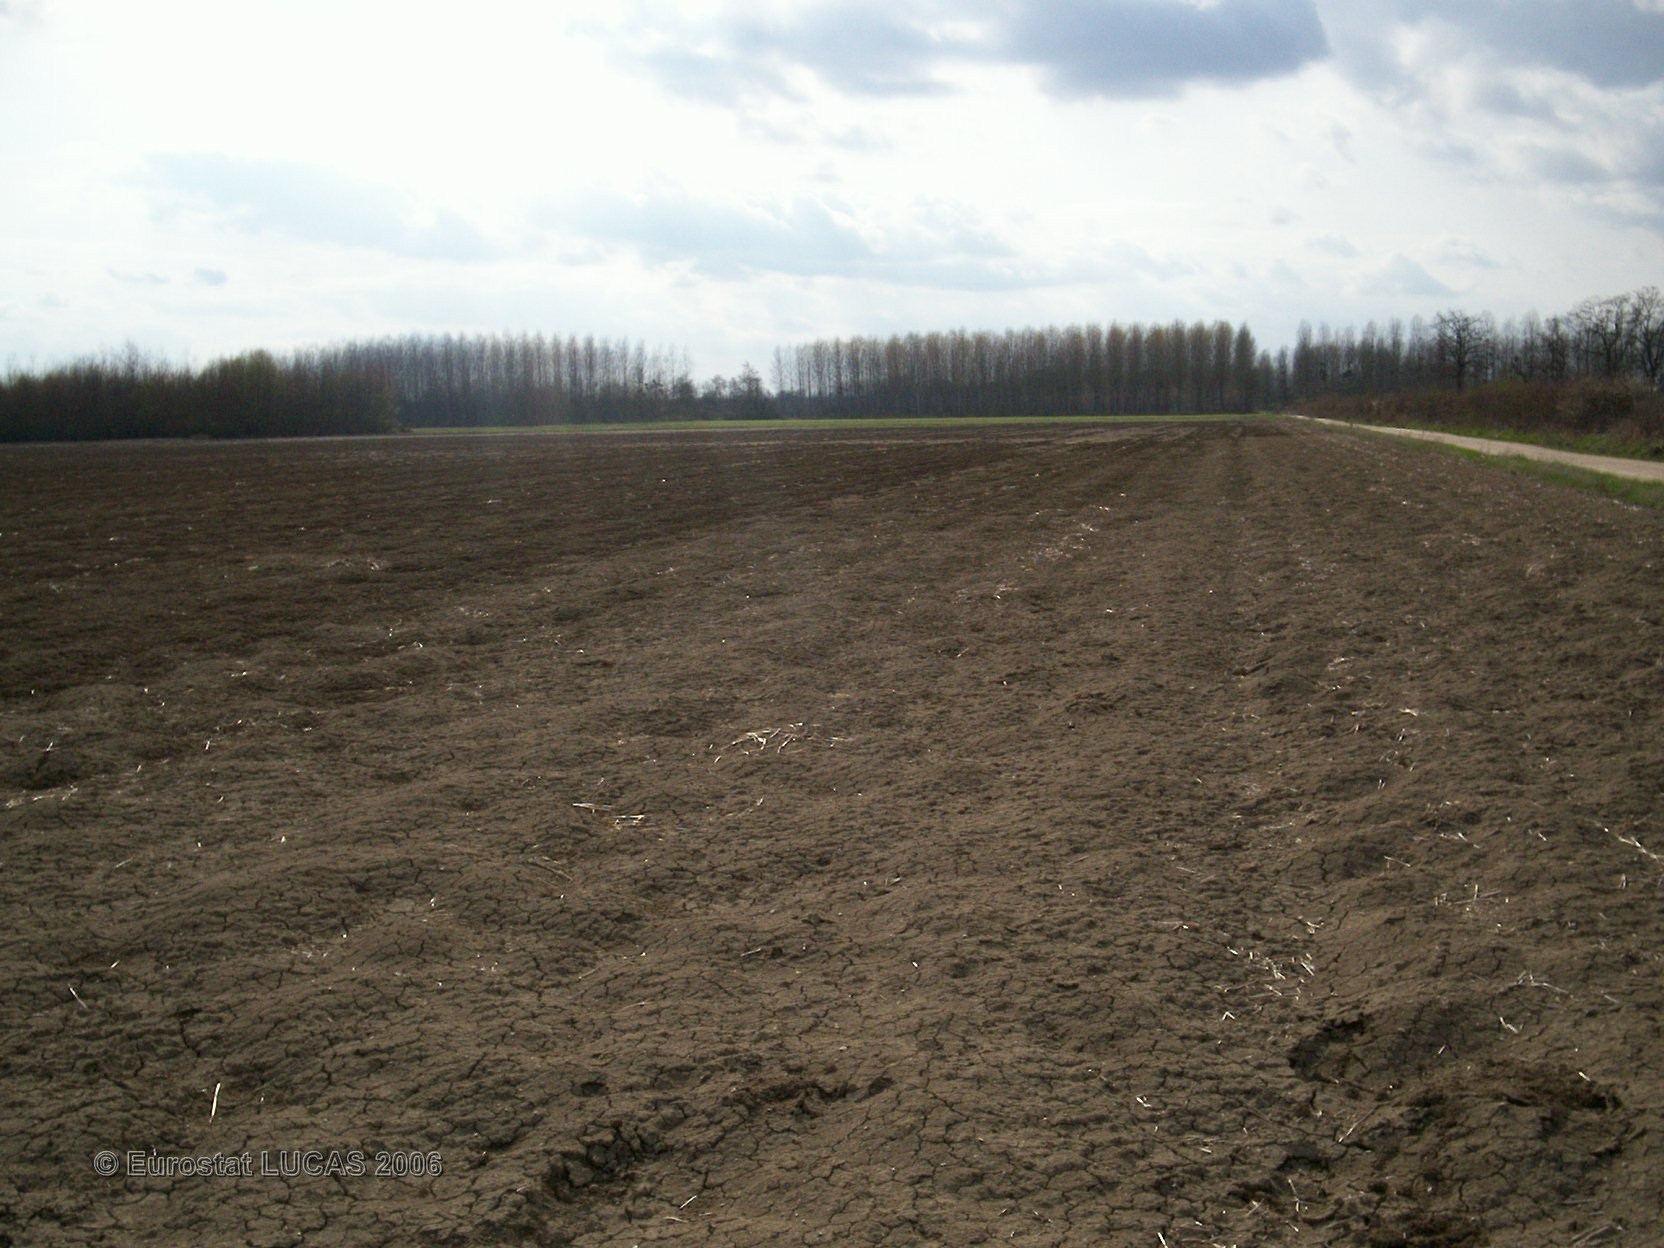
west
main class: Cropland
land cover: Other fibre and oleaginous crops
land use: Agriculture (excluding fallow land and kitchen gardens)
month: May
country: FR
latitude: 48.5634
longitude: 3.9655
